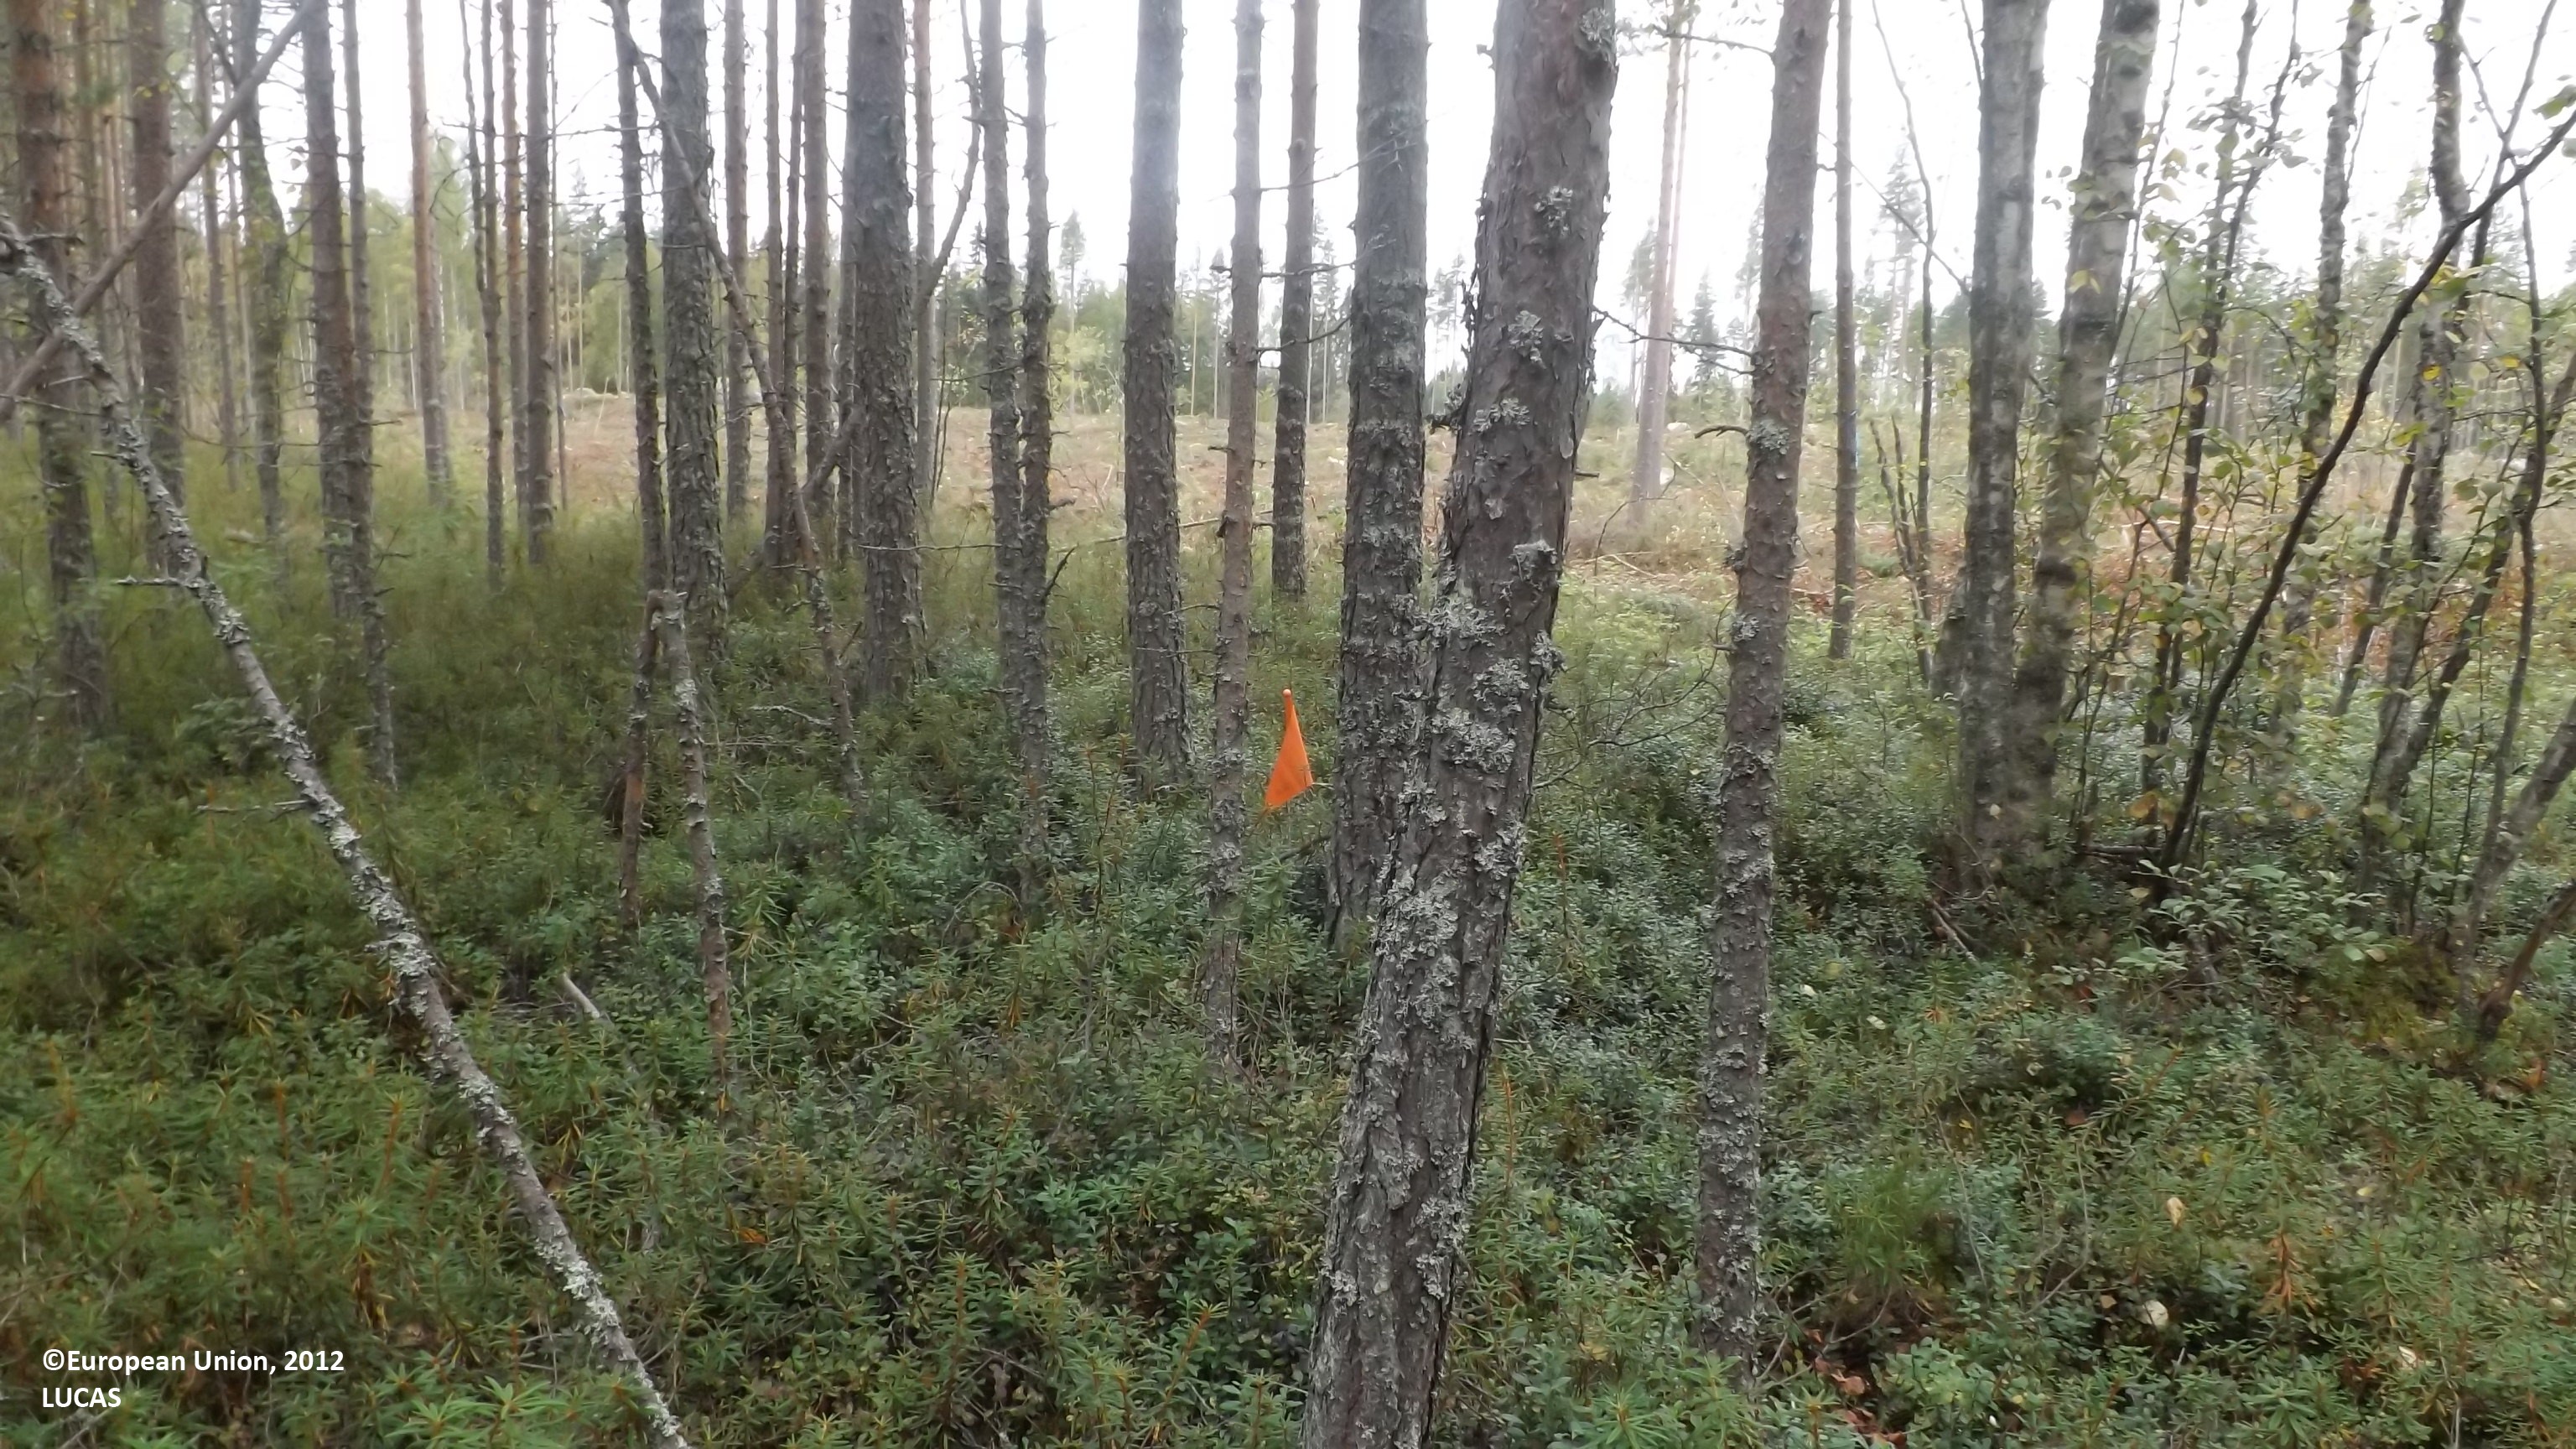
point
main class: Woodland
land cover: Pine dominated mixed woodland
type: boreal forest
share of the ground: 50 - 75 %
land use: Forestry
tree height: > 5 m
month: August
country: FI
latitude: 63.7981
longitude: 23.5179
